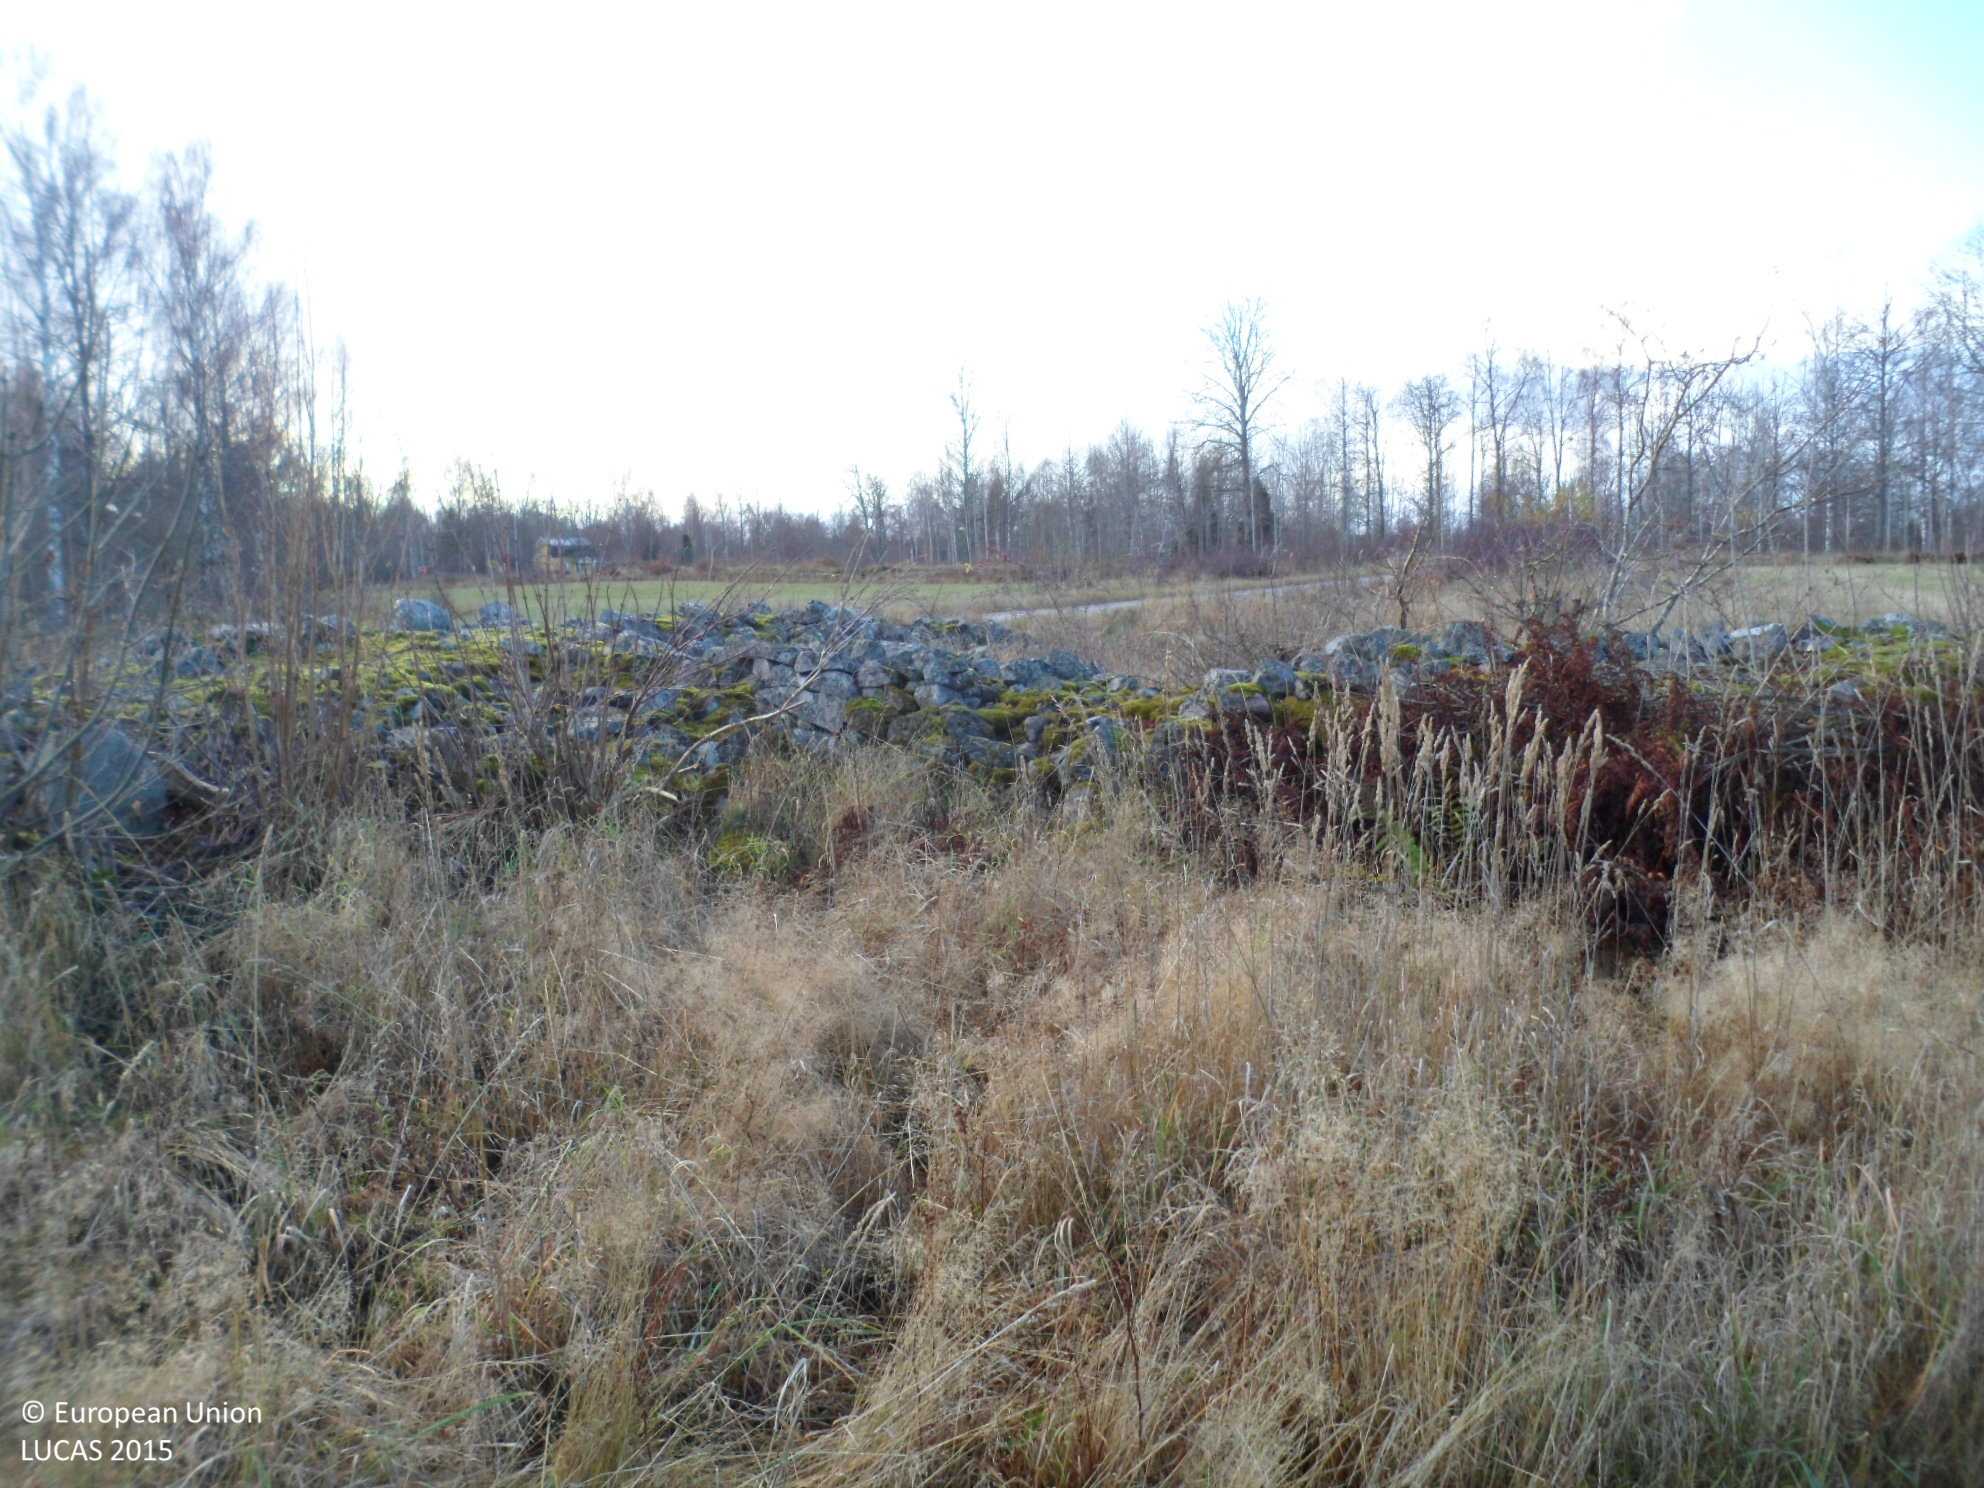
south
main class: Grassland
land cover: Grassland without tree/shrub cover
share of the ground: > 75 %
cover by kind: herbaceous plants 100 %
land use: Agriculture (excluding fallow land and kitchen gardens)
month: November
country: SE
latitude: 56.9536
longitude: 15.9017
